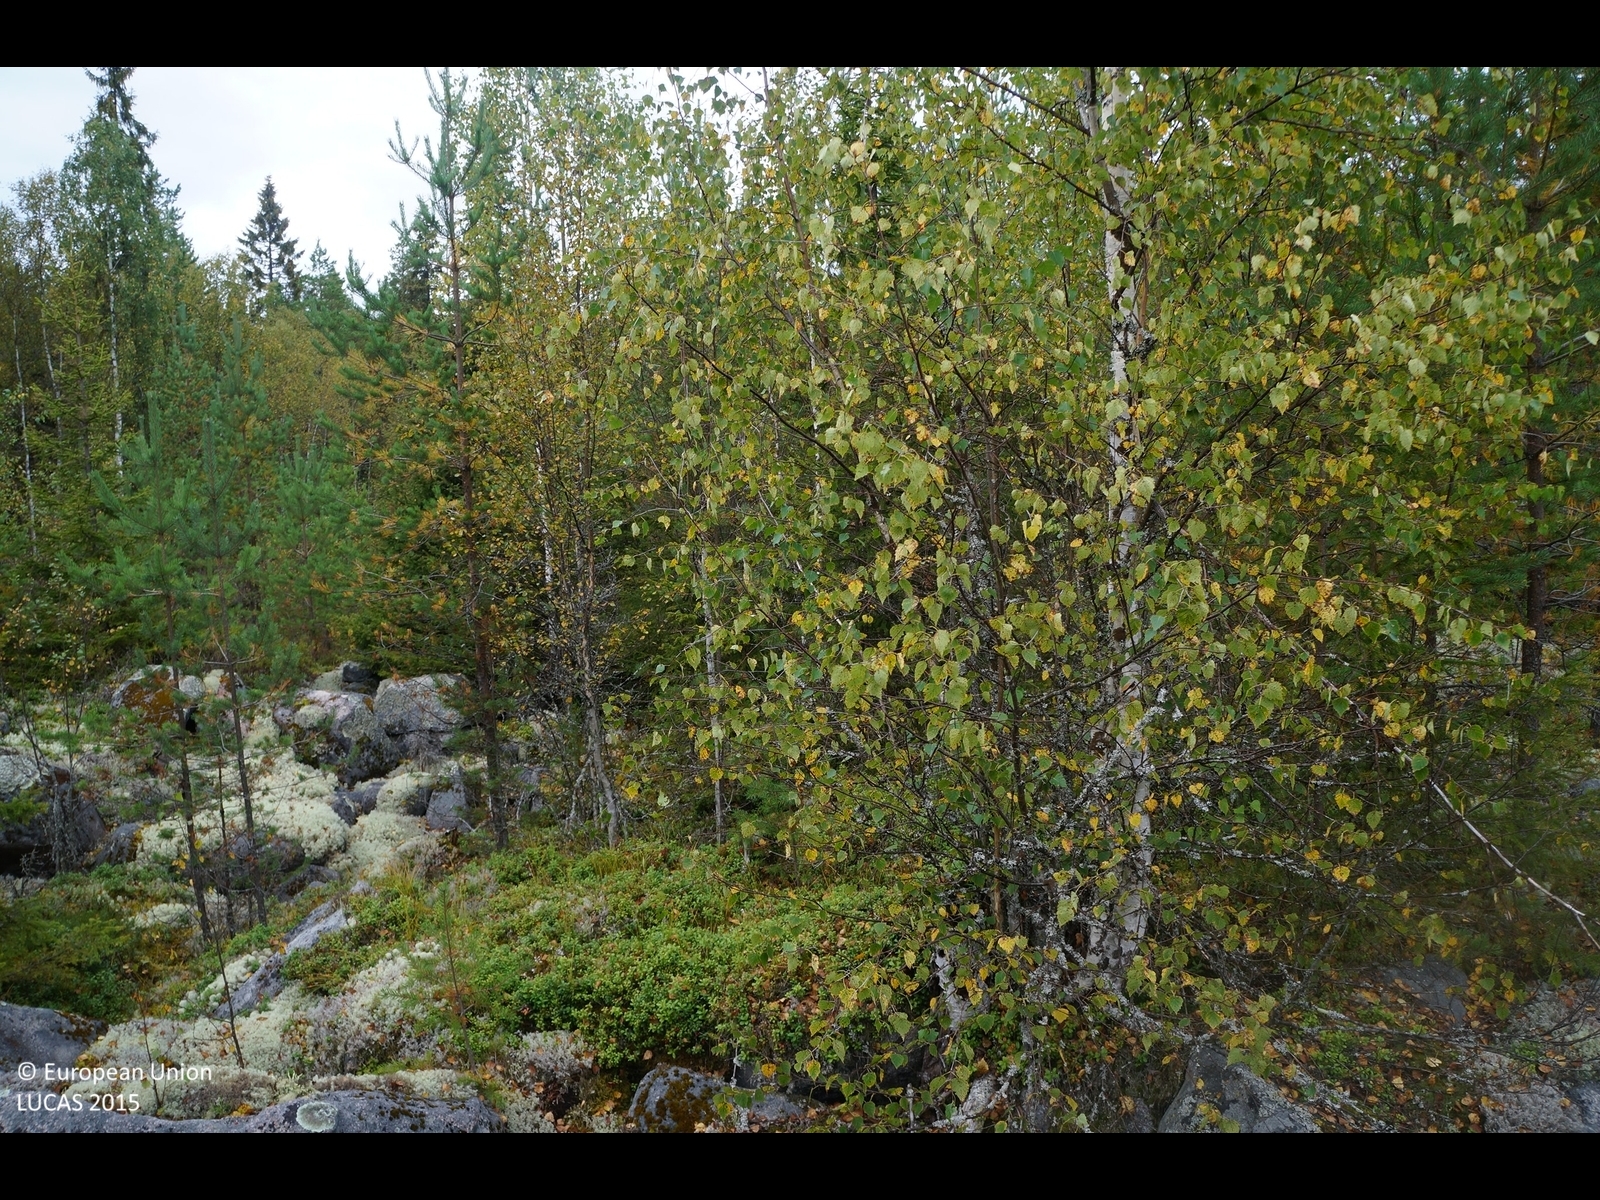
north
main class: Woodland
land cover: Other mixed woodland
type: boreal forest
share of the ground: 25 - 50 %
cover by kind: consolidated bare surface 40 %, lichens and mosses 20 %, coniferous forest trees 15 %, broadleaved forest trees 15 %, shrubs 10 %
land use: Semi-natural and natural areas not in use
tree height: < 5 m
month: September
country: FI
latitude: 64.0552
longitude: 24.1414
